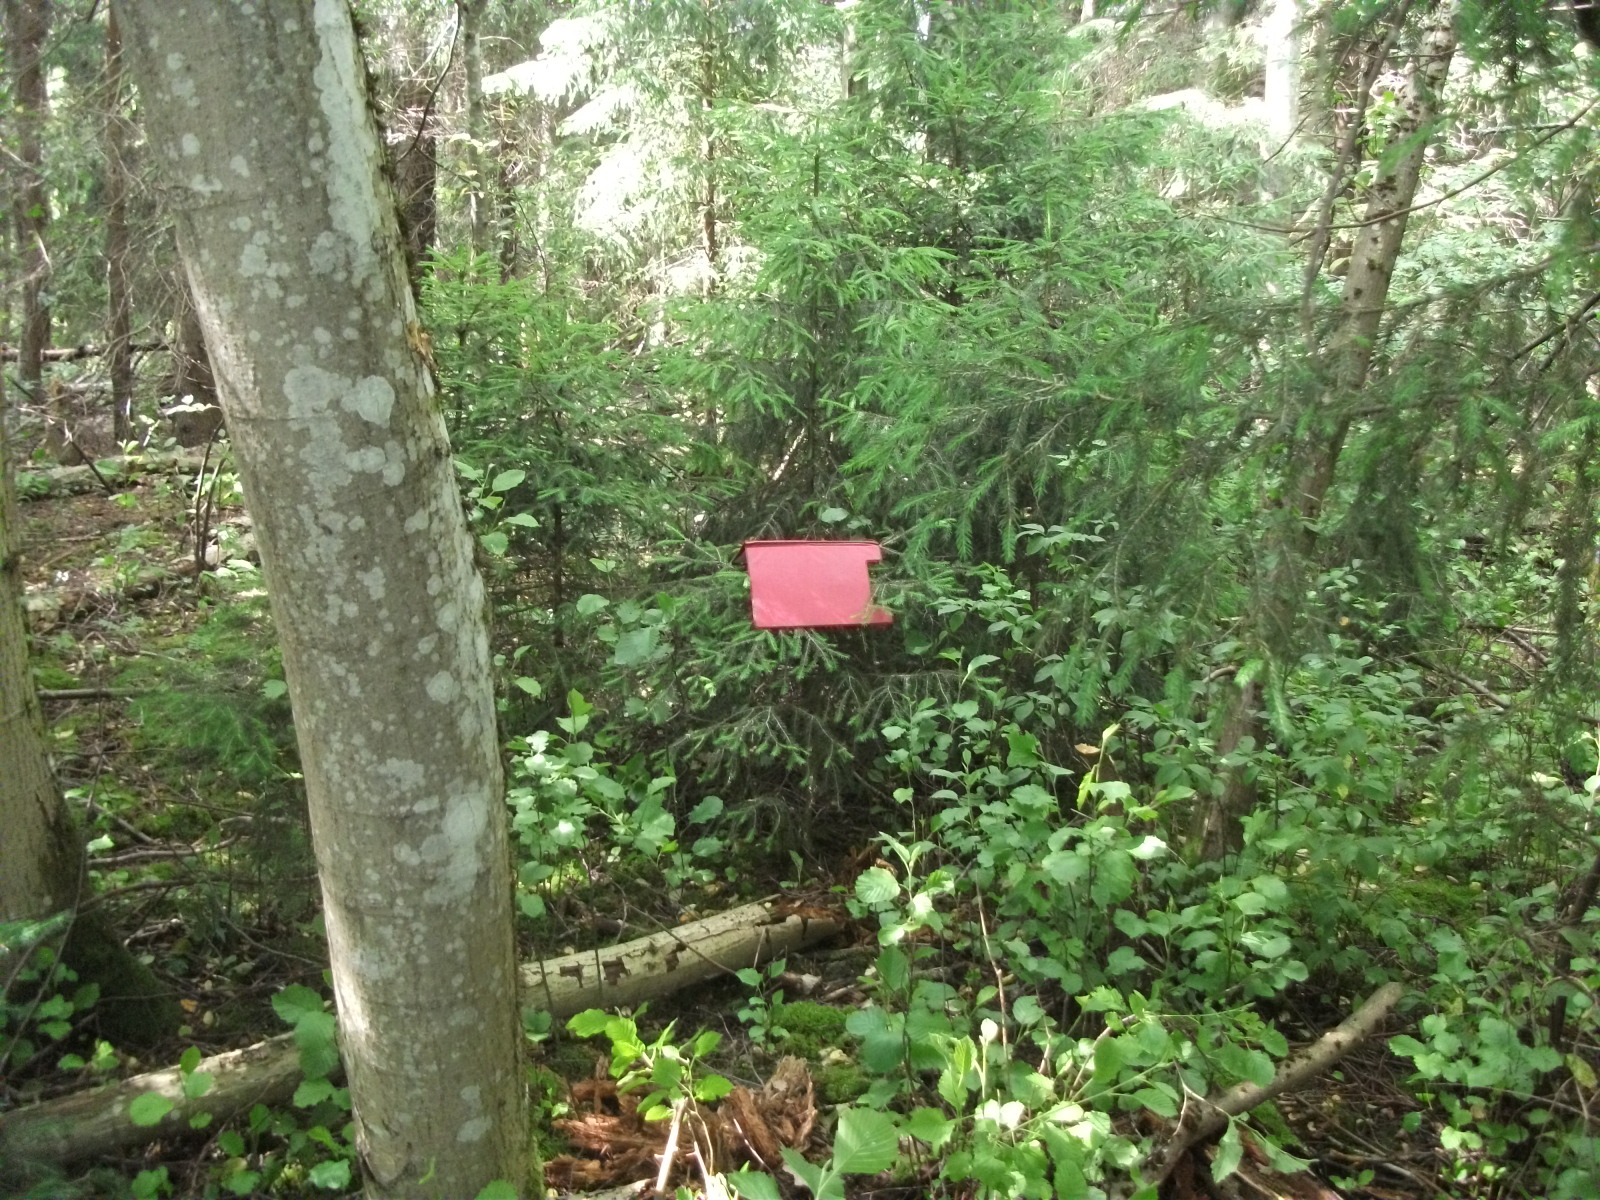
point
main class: Woodland
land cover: Spruce dominated mixed woodland
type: hemiboreal forest and nemoral coniferous forest and mixed broadleaved-coniferous forest
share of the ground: > 75 %
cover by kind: coniferous forest trees 60 %, broadleaved forest trees 30 %, herbaceous plants 10 %
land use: Forestry
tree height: > 5 m
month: July
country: LV
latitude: 57.1301
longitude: 25.9387
